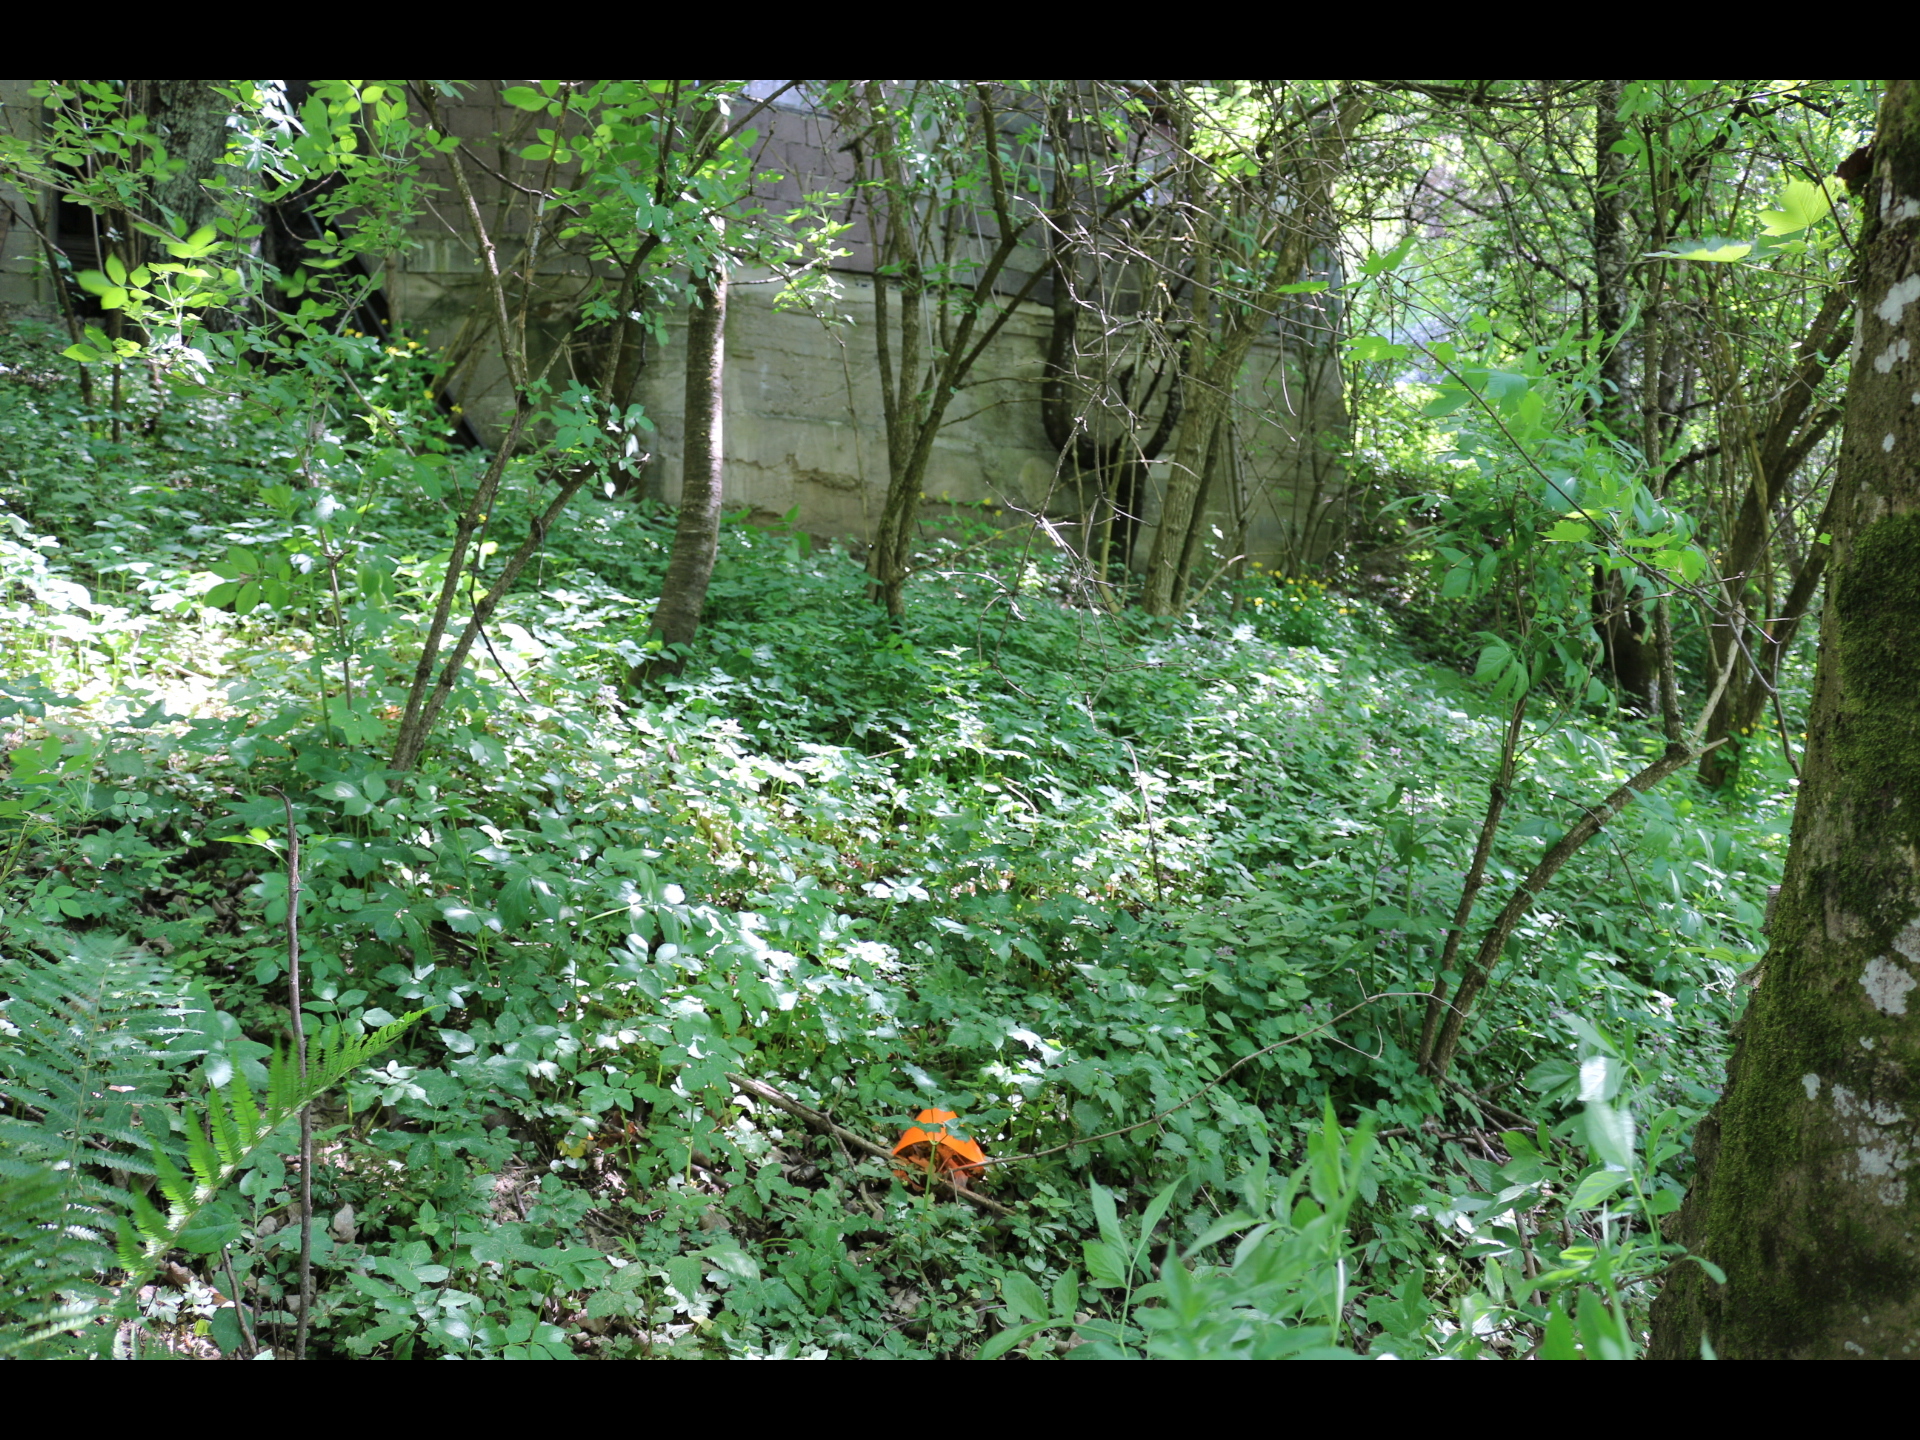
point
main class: Woodland
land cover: Spruce dominated mixed woodland
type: alpine coniferous forest
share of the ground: > 75 %
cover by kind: broadleaved forest trees 65 %, coniferous forest trees 35 %
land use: Forestry
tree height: > 5 m
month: May
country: AT
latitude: 46.7462
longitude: 14.4351
